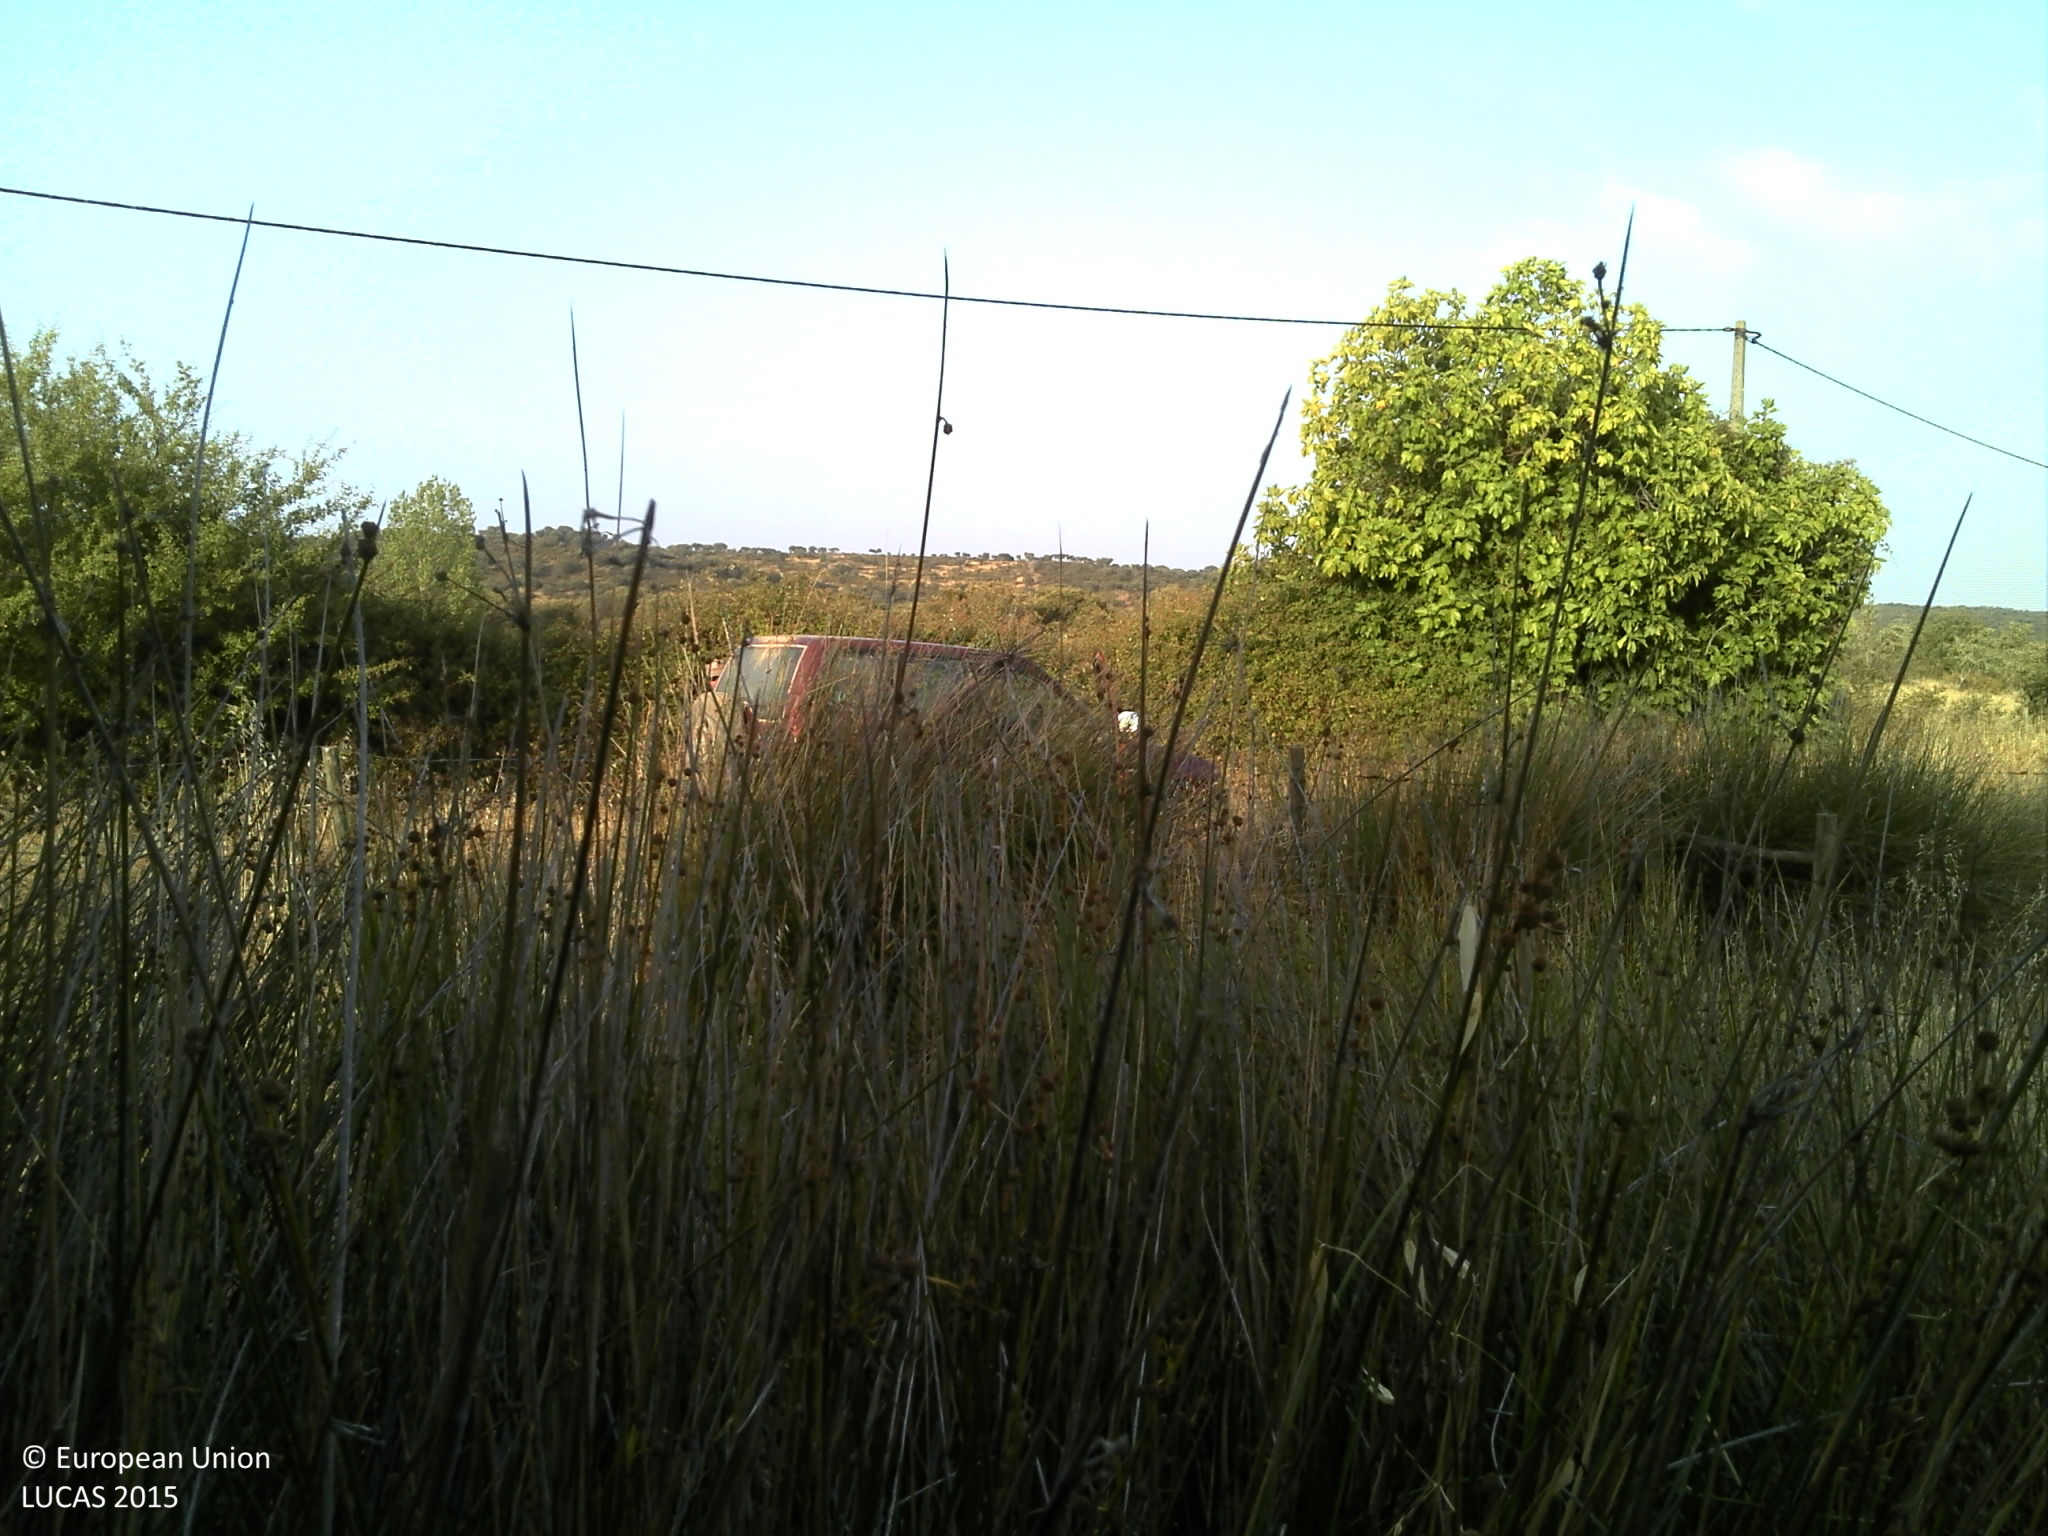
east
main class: Woodland
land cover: Broadleaved woodland
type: broadleaved evergreen forest
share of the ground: 10 - 25 %
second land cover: Grassland without tree/shrub cover
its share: 50 - 75 %
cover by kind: herbaceous plants 65 %, unconsolidated bare surface 20 %, broadleaved forest trees 10 %, shrubs 5 %
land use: Forestry
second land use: Agriculture (excluding fallow land and kitchen gardens)
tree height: < 5 m
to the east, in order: Broadleaved woodland; Grassland without tree/shrub cover; Fences; Shruby margins; Ditches and canals; Grass margins; Paved roads, cycling and walking lanes; Grass margins; Ditches and canals; Electric lines; Shruby margins; Fences; Grassland with sparse tree/shrub cover; Broadleaved woodland; Grassland with sparse tree/shrub cover; Broadleaved woodland; Fences; Grassland with sparse tree/shrub cover; Broadleaved woodland
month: July
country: PT
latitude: 38.6848
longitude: -7.3764
